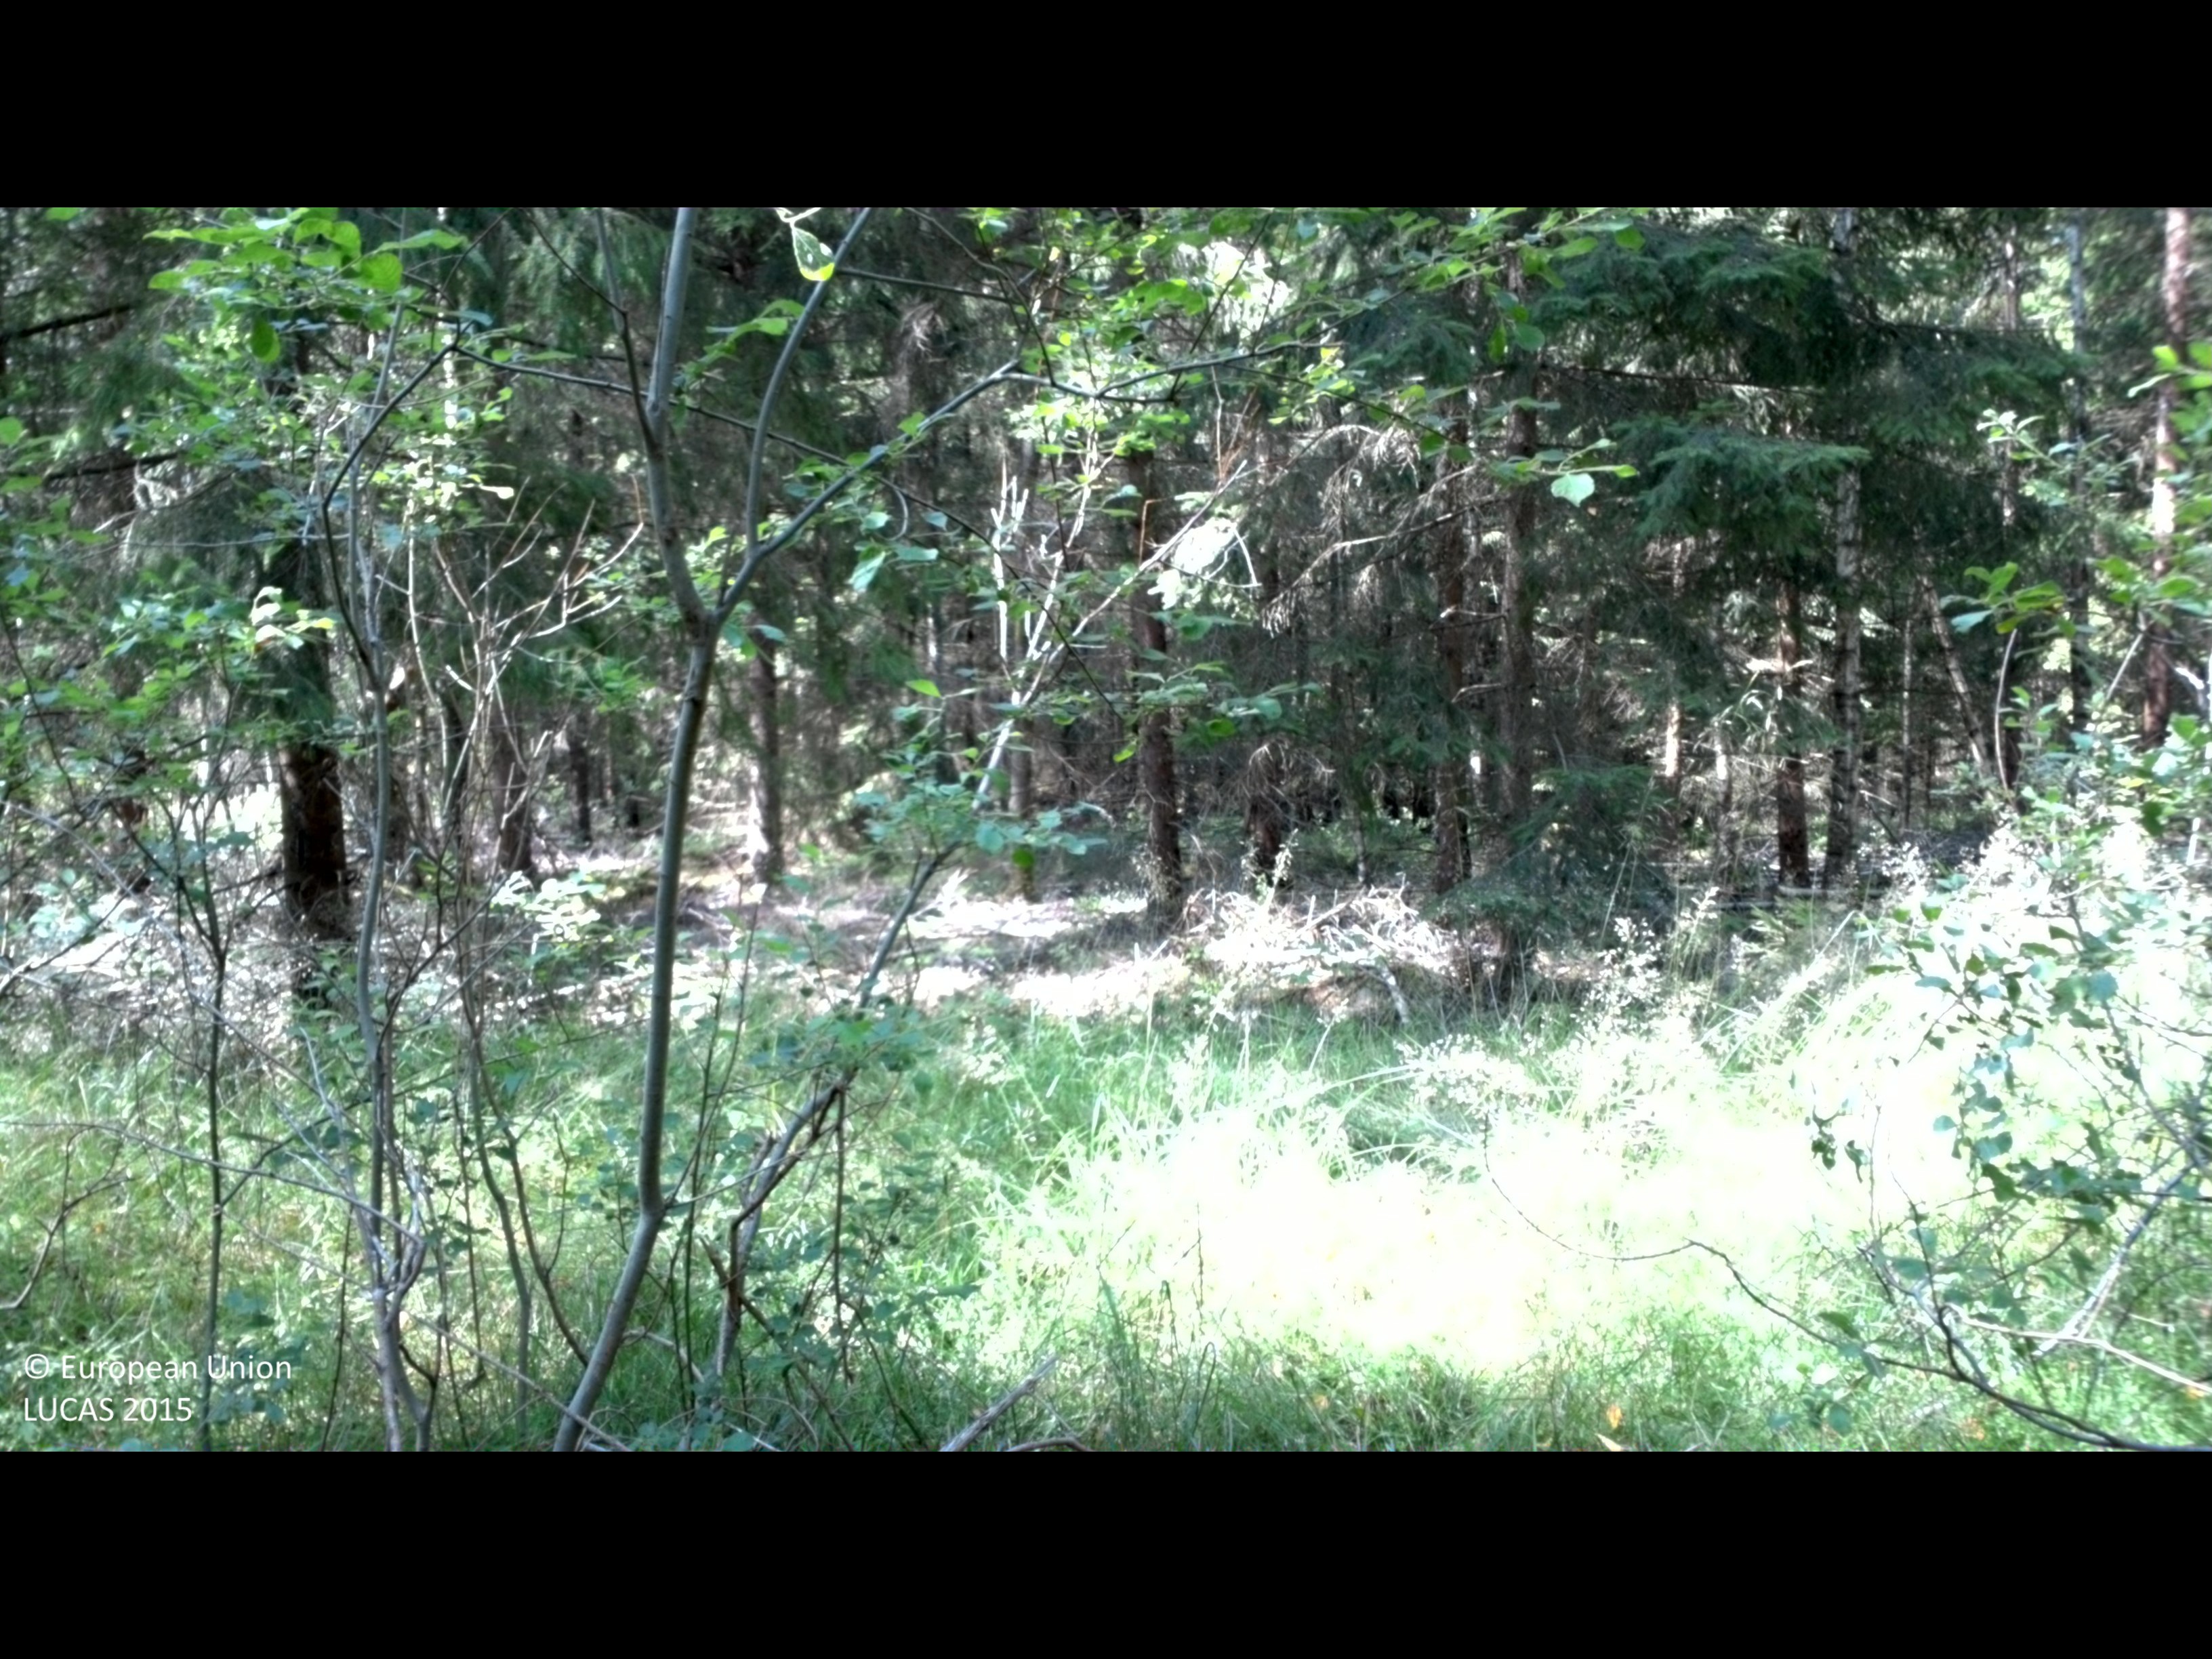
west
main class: Woodland
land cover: Spruce dominated mixed woodland
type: boreal forest
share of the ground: 50 - 75 %
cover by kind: coniferous forest trees 45 %, herbaceous plants 25 %, broadleaved forest trees 15 %, shrubs 15 %
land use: Forestry
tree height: > 5 m
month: August
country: SE
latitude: 56.4052
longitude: 14.2593
